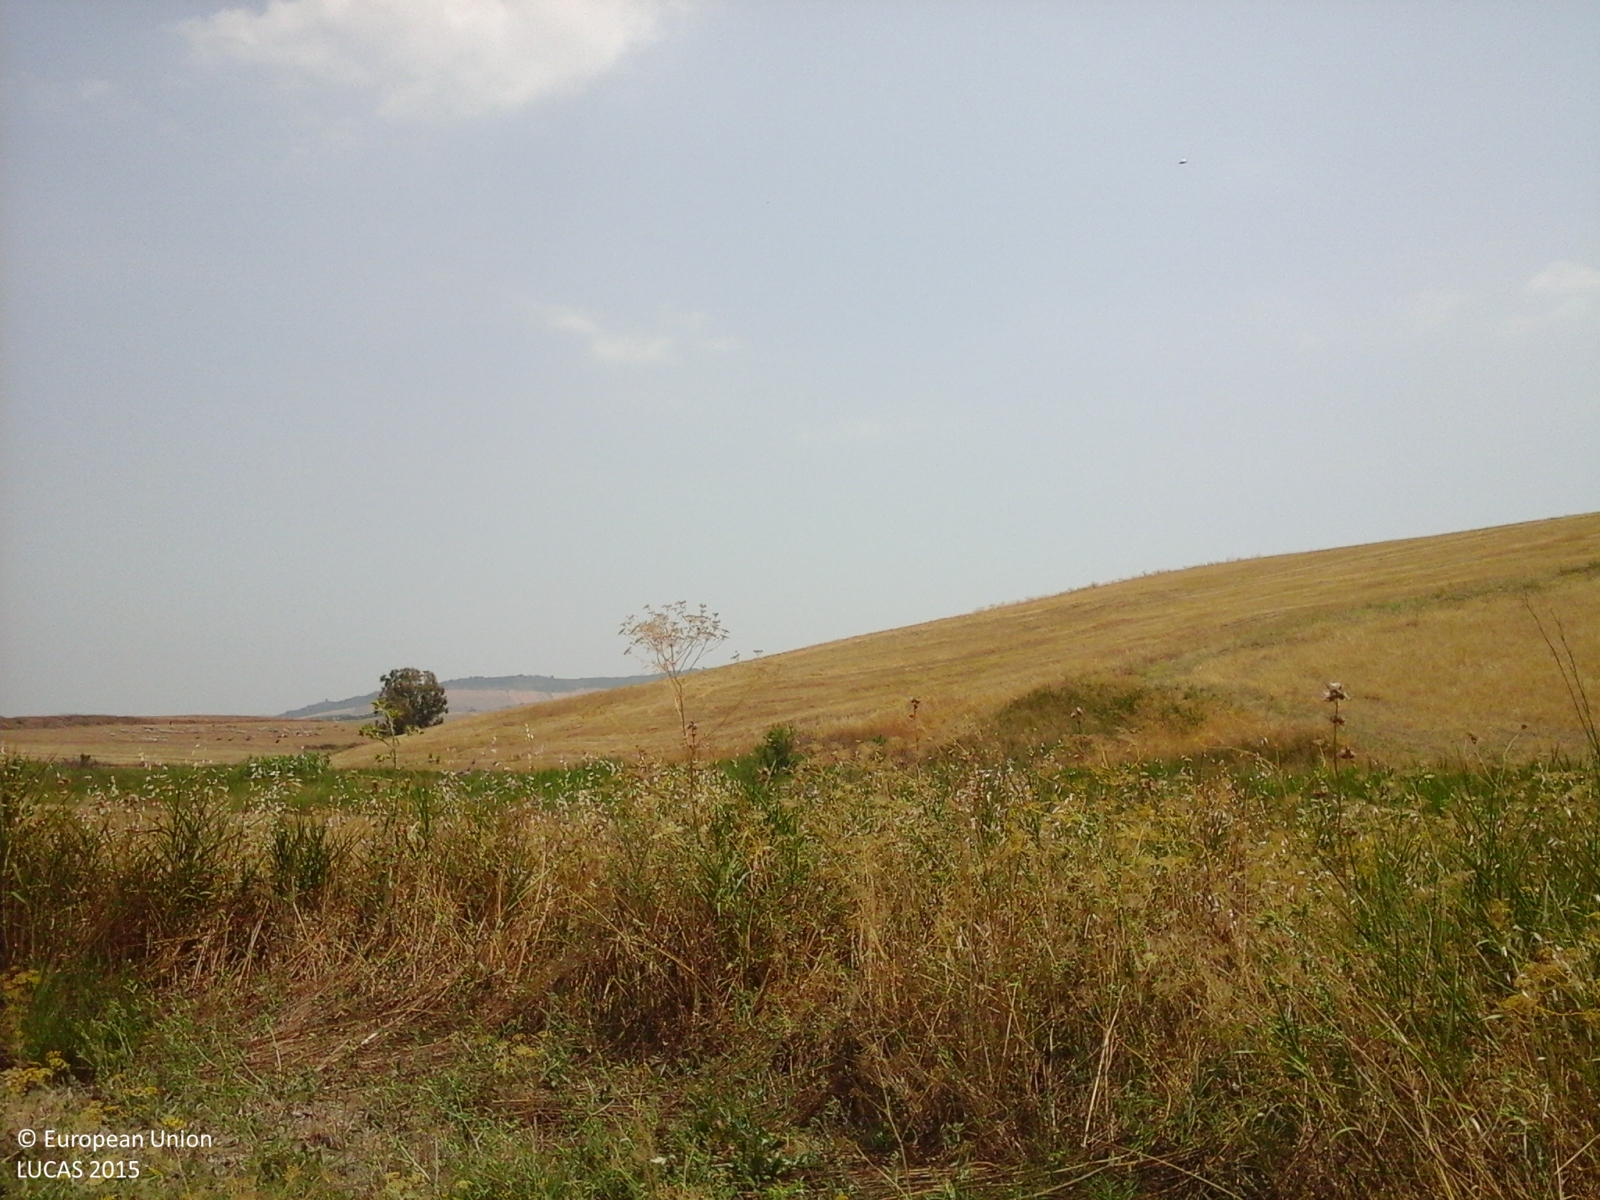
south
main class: Grassland
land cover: Grassland without tree/shrub cover
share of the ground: > 75 %
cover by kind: herbaceous plants 100 %
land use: Semi-natural and natural areas not in use
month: July
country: IT
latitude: 37.3381
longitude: 13.9540
